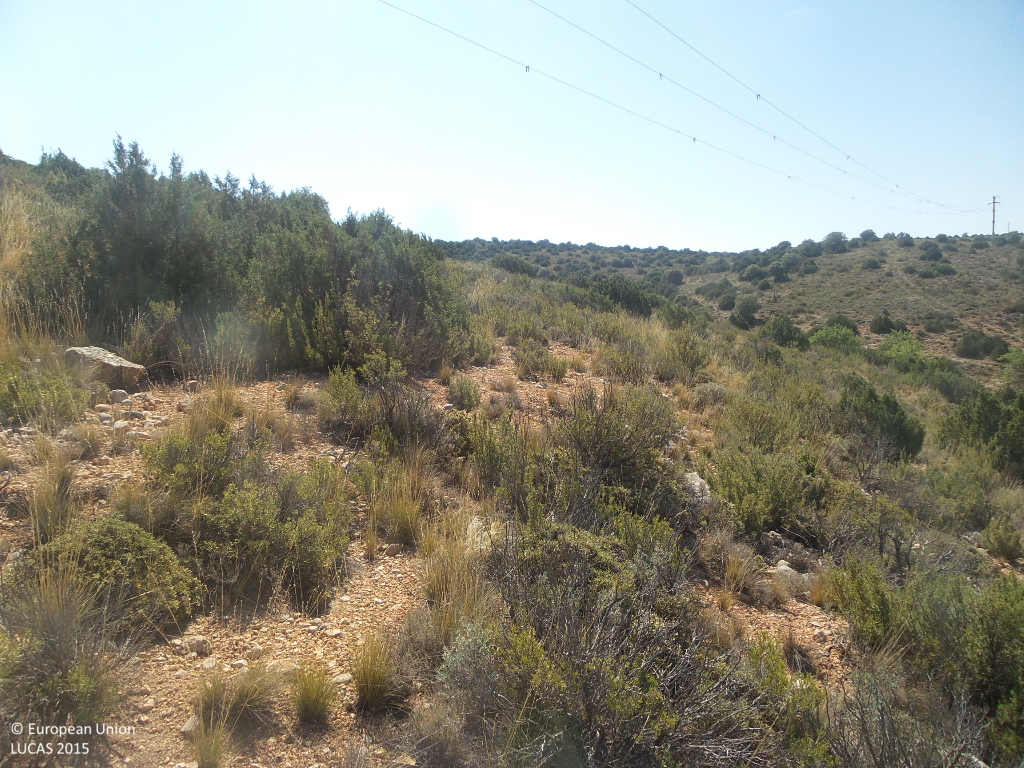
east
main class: Shrubland
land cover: Shrubland without tree cover
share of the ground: 50 - 75 %
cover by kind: shrubs 60 %, unconsolidated bare surface 35 %, herbaceous plants 5 %
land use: Semi-natural and natural areas not in use
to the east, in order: Shrubland without tree cover; Electric lines; Shrubland without tree cover; Shrubland with sparse tree cover; Shrubland without tree cover
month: July
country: ES
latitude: 41.1466
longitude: -1.9048
